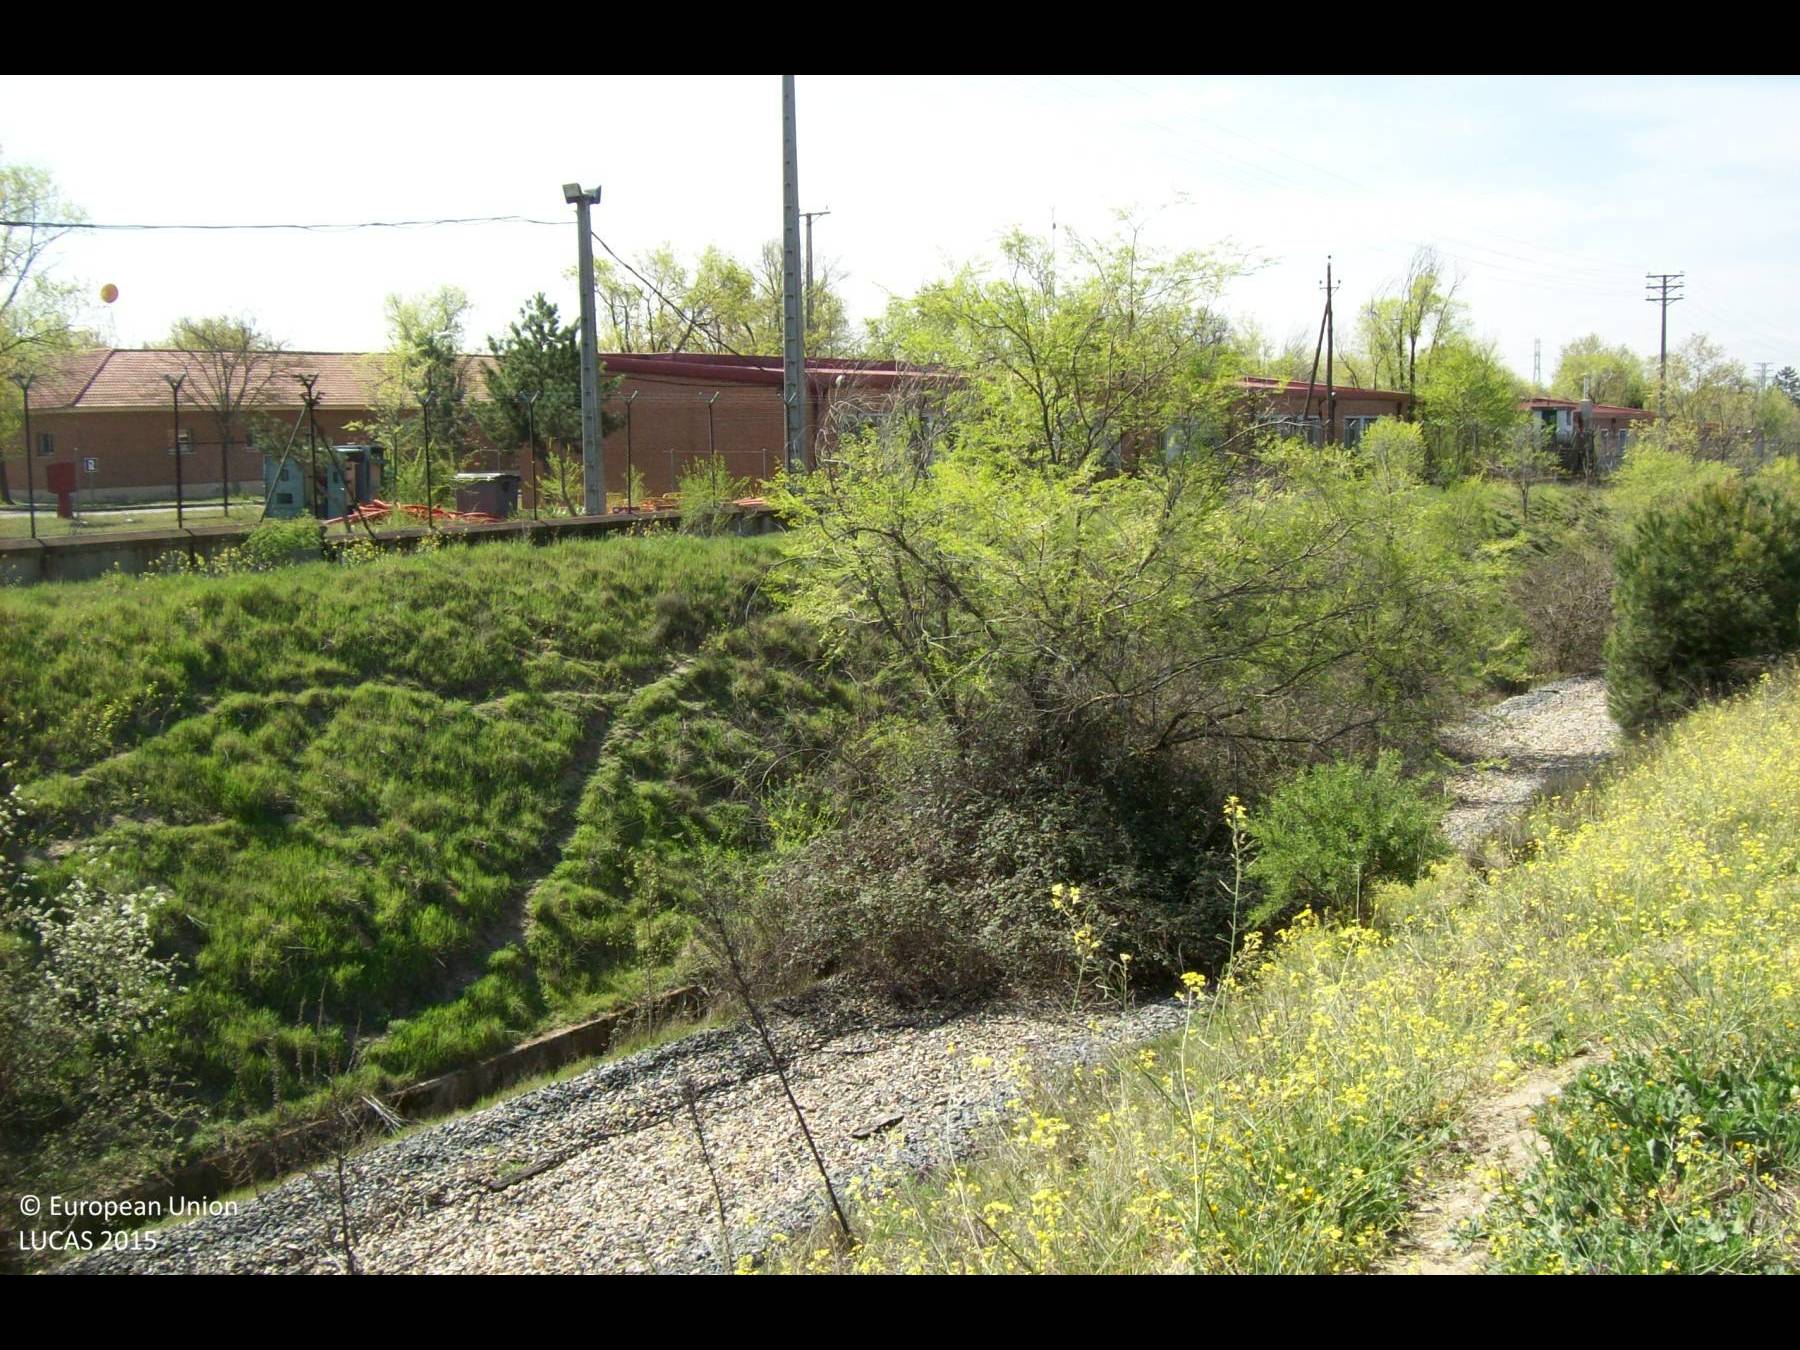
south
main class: Grassland
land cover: Grassland without tree/shrub cover
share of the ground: 50 - 75 %
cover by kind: herbaceous plants 70 %
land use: Community services
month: April
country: ES
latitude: 40.3672
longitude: -3.8051
